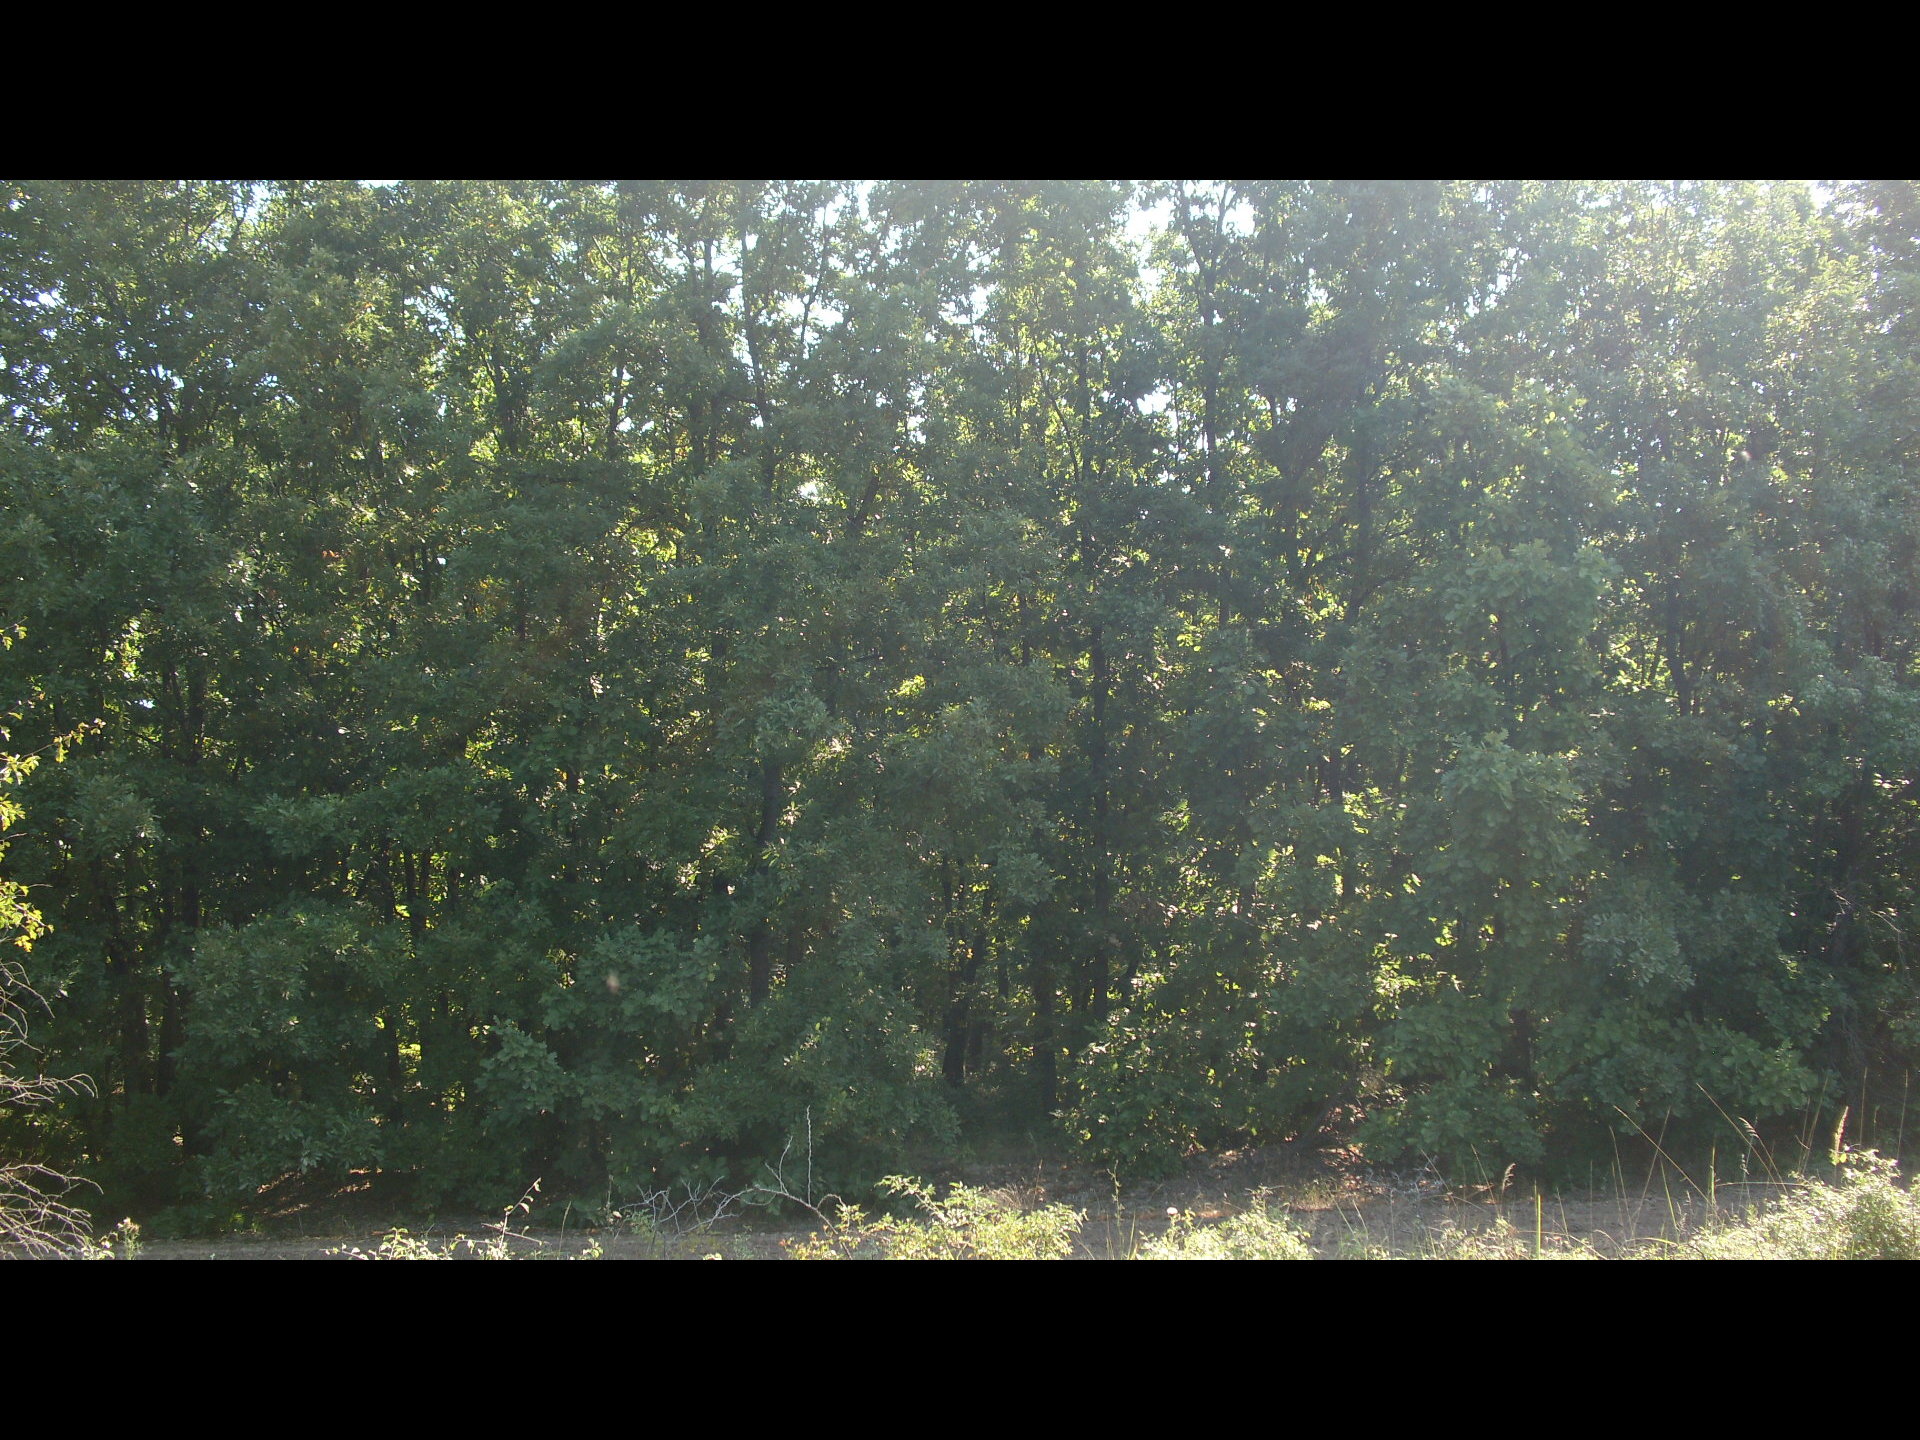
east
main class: Shrubland
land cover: Shrubland with sparse tree cover
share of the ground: > 75 %
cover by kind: shrubs 80 %, herbaceous plants 15 %, broadleaved forest trees 5 %
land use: Semi-natural and natural areas not in use
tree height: < 5 m
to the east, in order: Shrubland with sparse tree cover; Tracks; Broadleaved woodland; Tracks; Broadleaved woodland
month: September
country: BG
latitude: 44.0556
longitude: 22.5810
